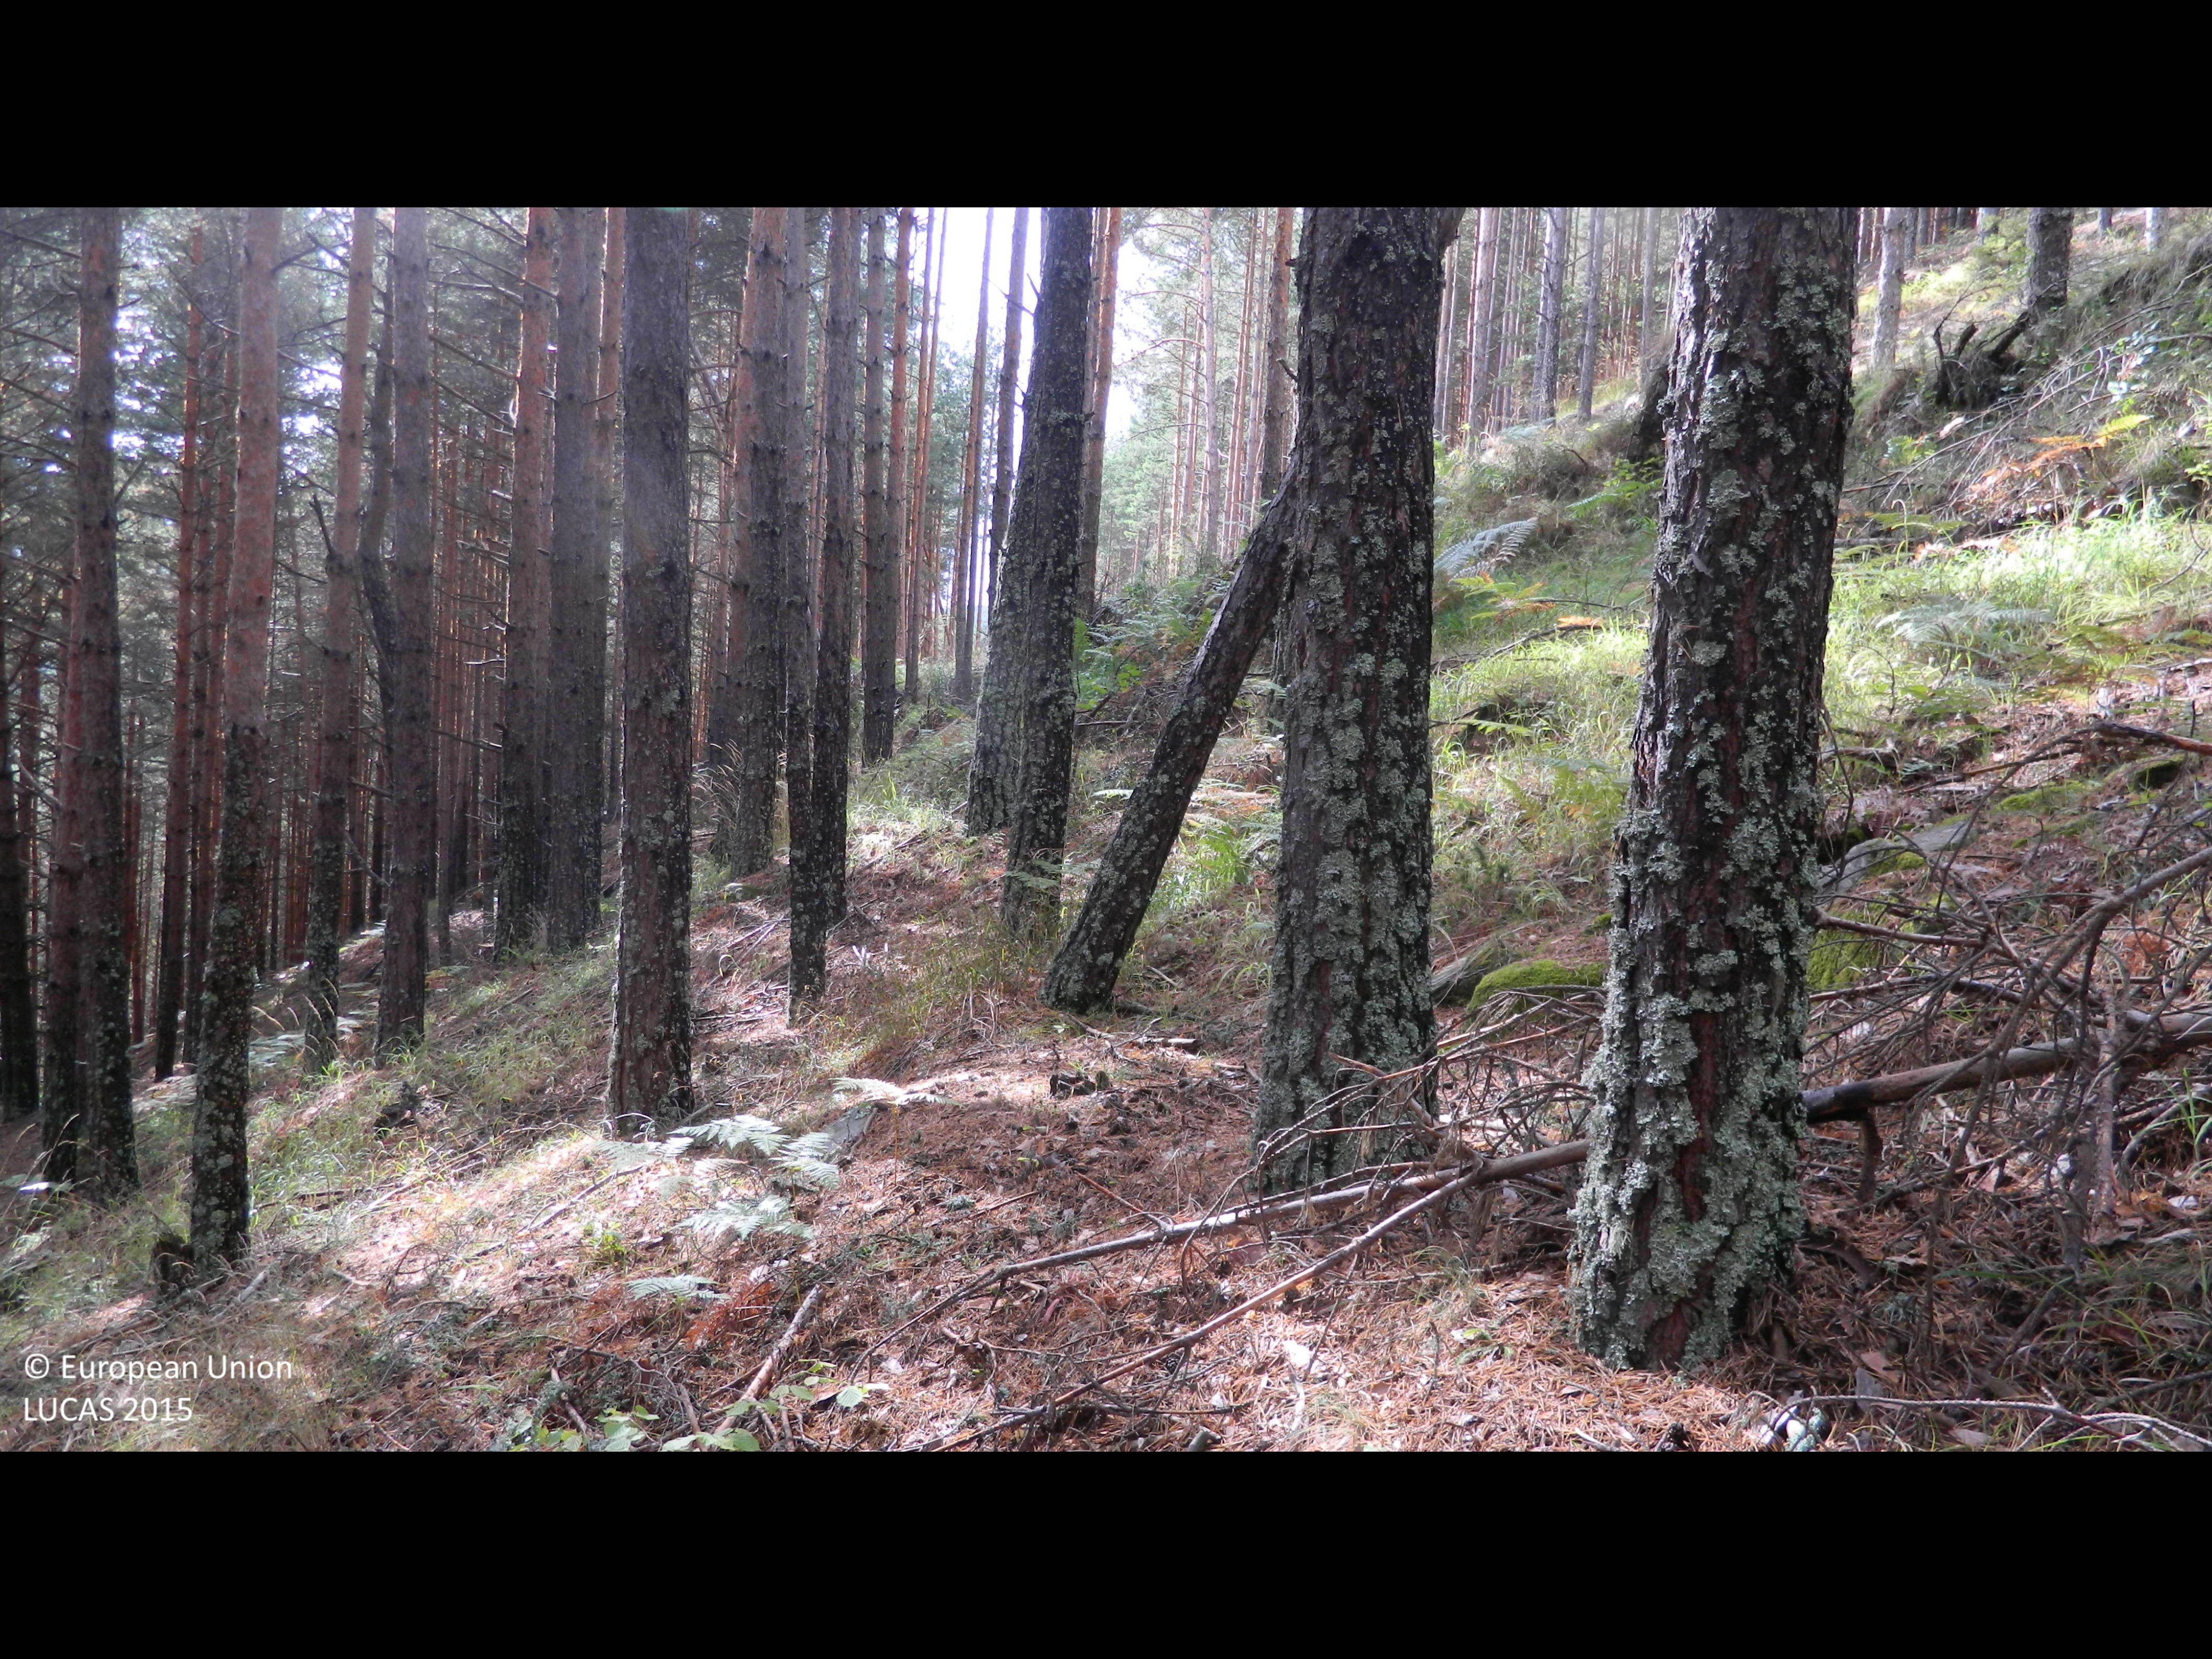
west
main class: Woodland
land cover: Pine dominated coniferous woodland
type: hemiboreal forest and nemoral coniferous forest and mixed broadleaved-coniferous forest
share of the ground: > 75 %
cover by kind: coniferous forest trees 100 %
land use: Forestry
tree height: > 5 m
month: September
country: BG
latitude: 41.6269
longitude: 24.0897
